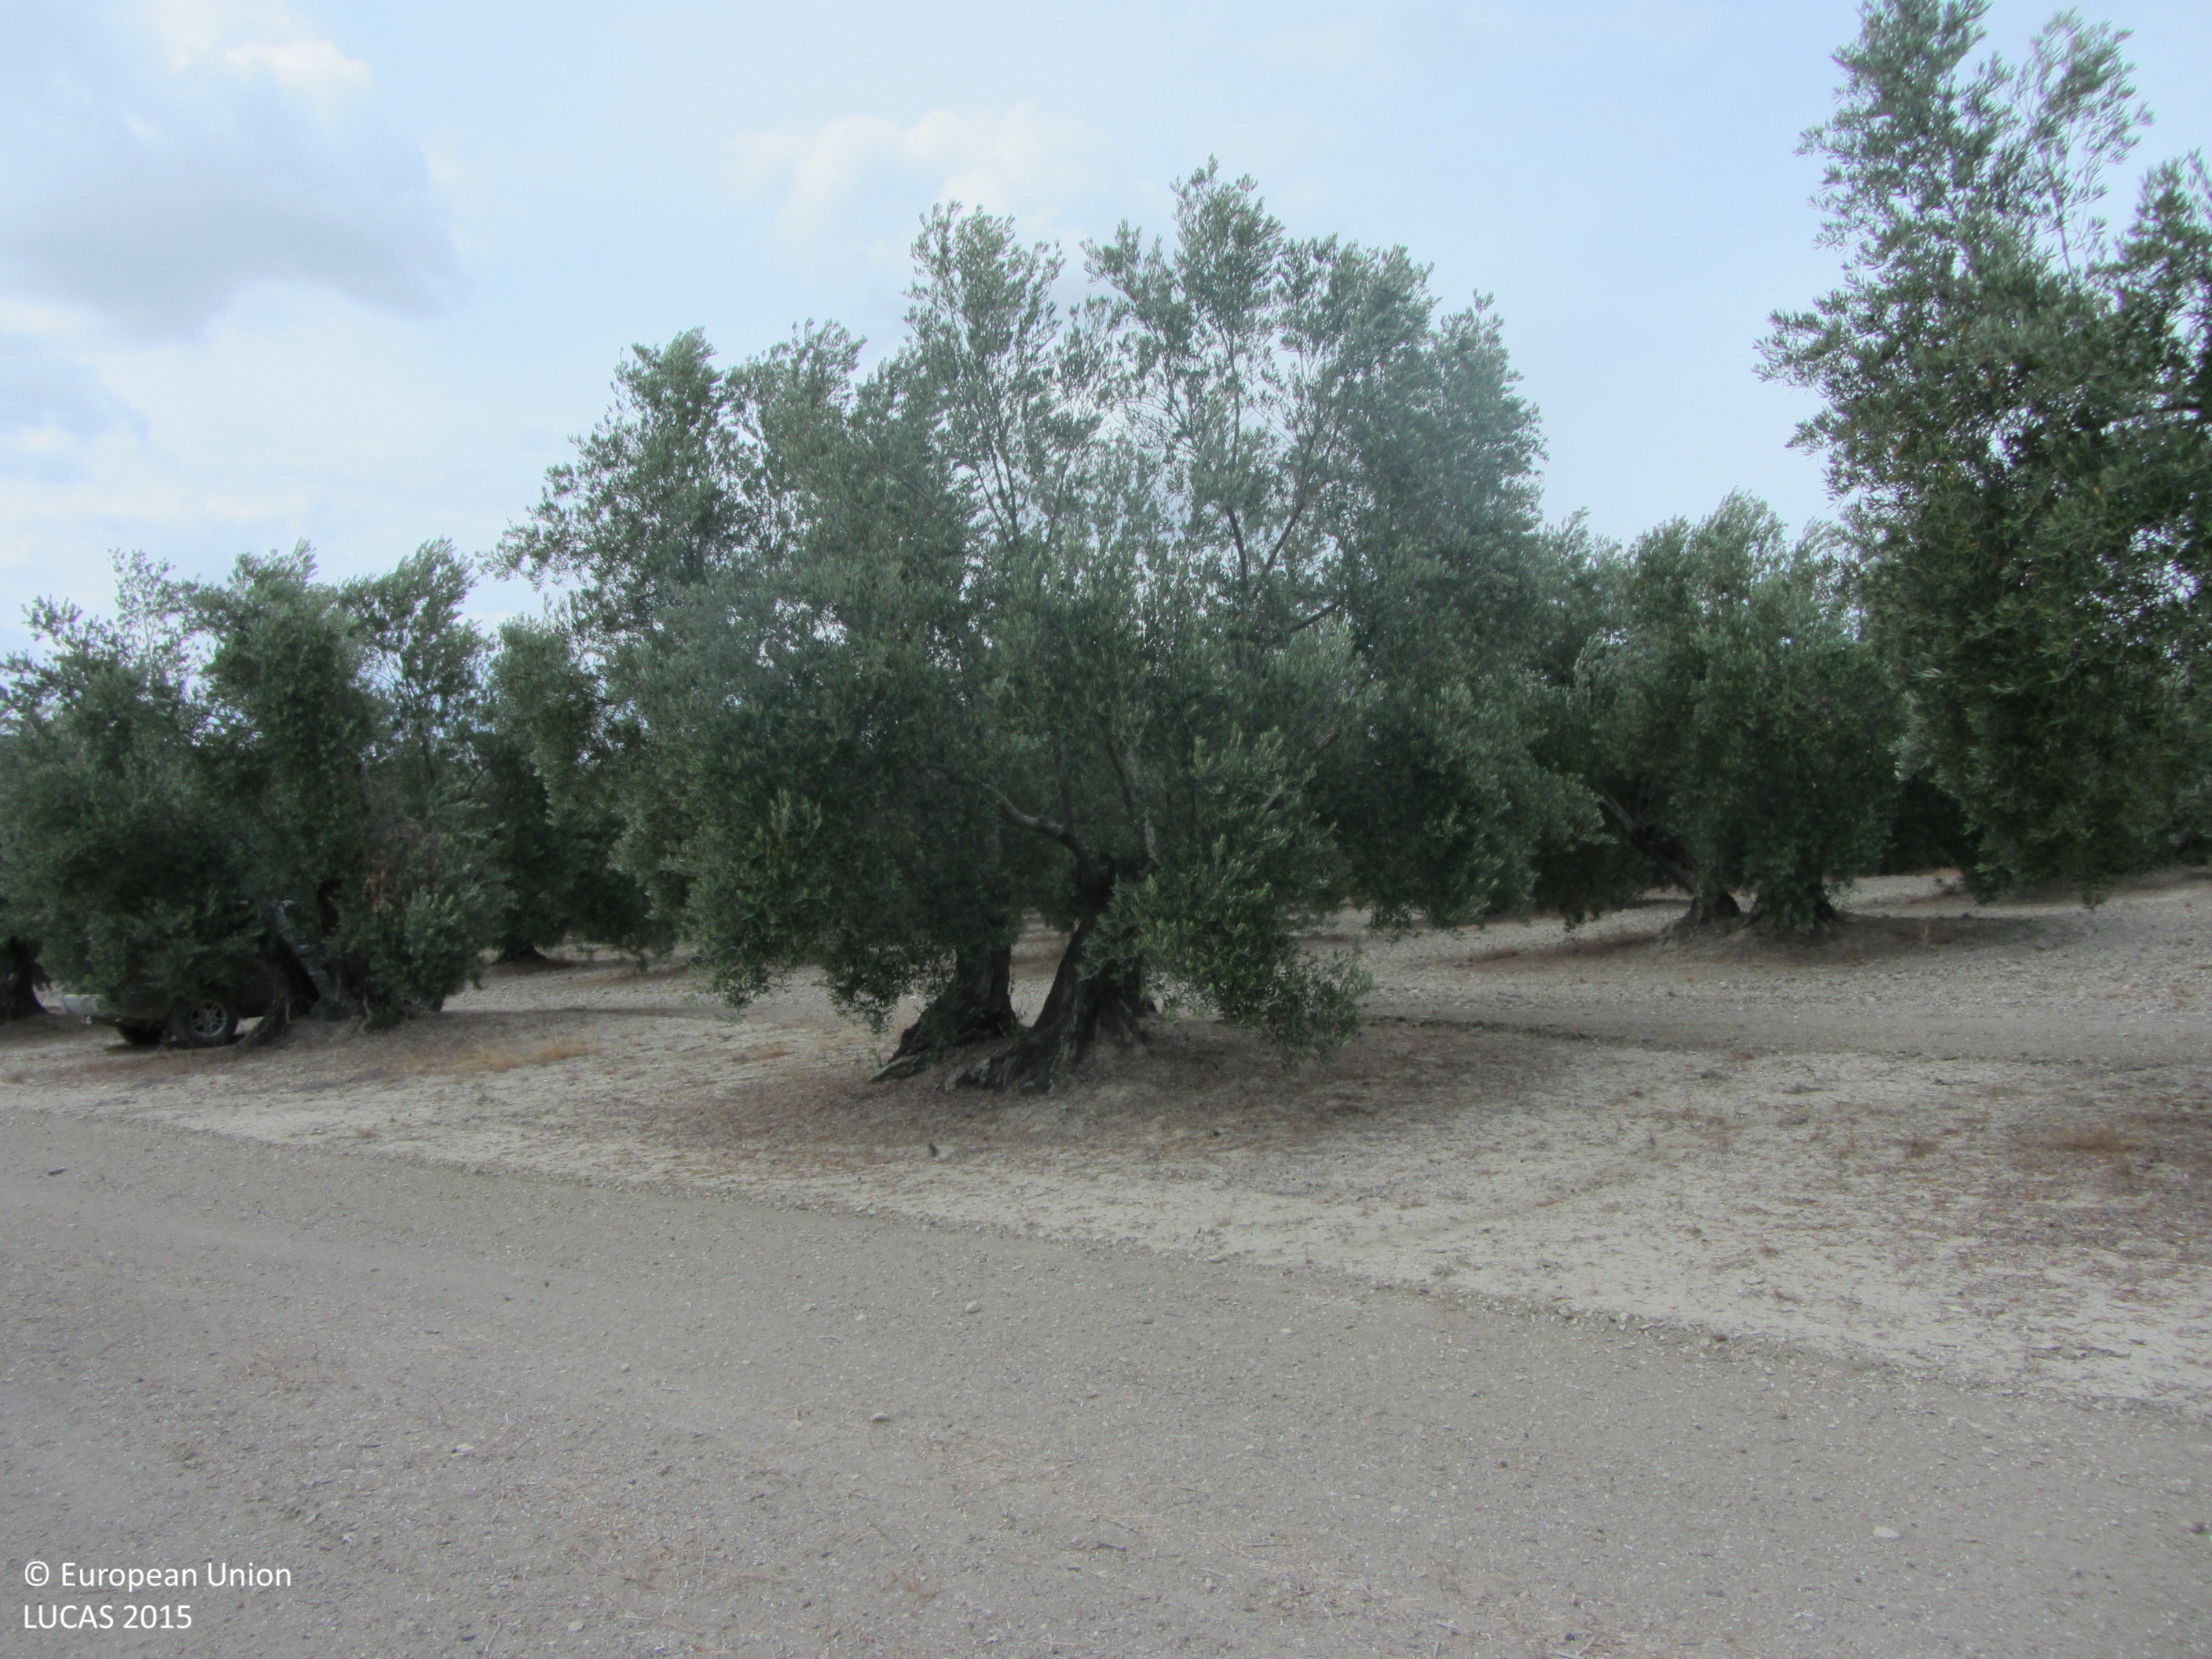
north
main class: Cropland
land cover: Olive groves
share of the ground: 25 - 50 %
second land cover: Other bare soil
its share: > 75 %
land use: Agriculture (excluding fallow land and kitchen gardens)
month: June
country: ES
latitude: 38.0060
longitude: -3.2670
